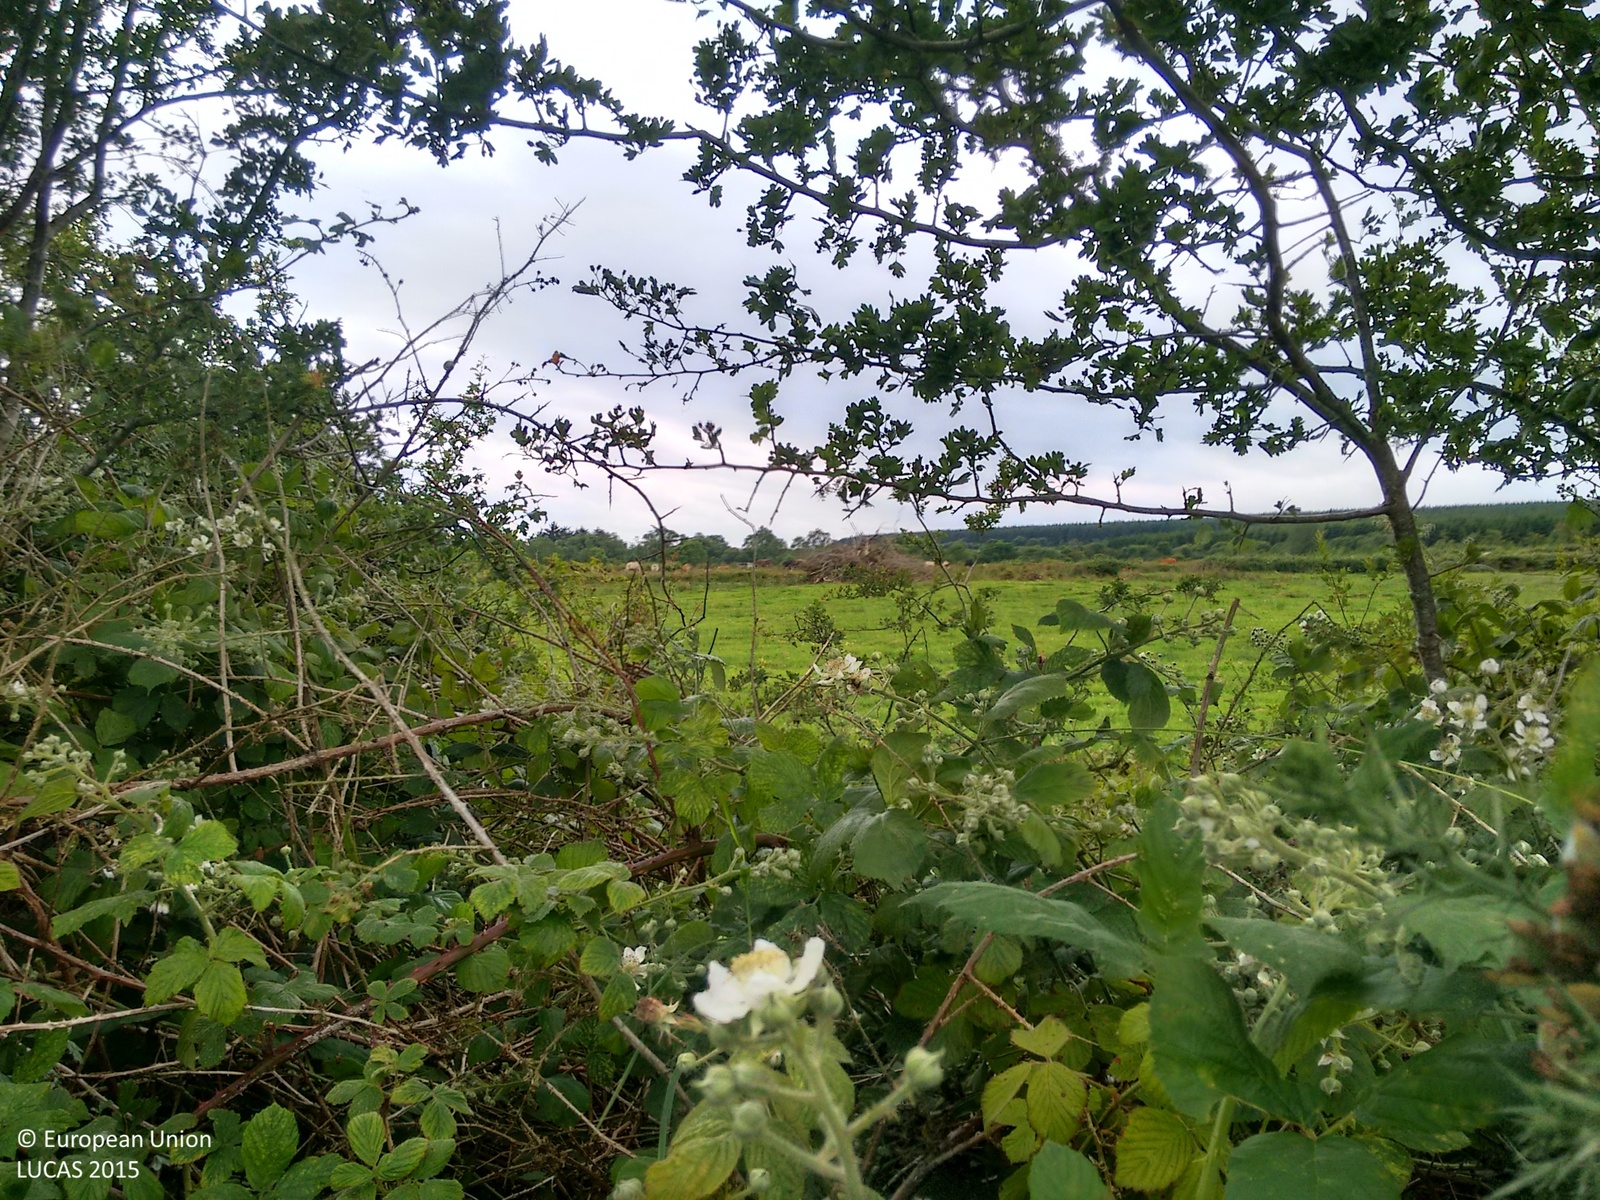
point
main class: Grassland
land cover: Grassland without tree/shrub cover
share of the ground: > 75 %
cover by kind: herbaceous plants 100 %
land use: Agriculture (excluding fallow land and kitchen gardens)
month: July
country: IE
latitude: 53.7274
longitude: -8.0462
